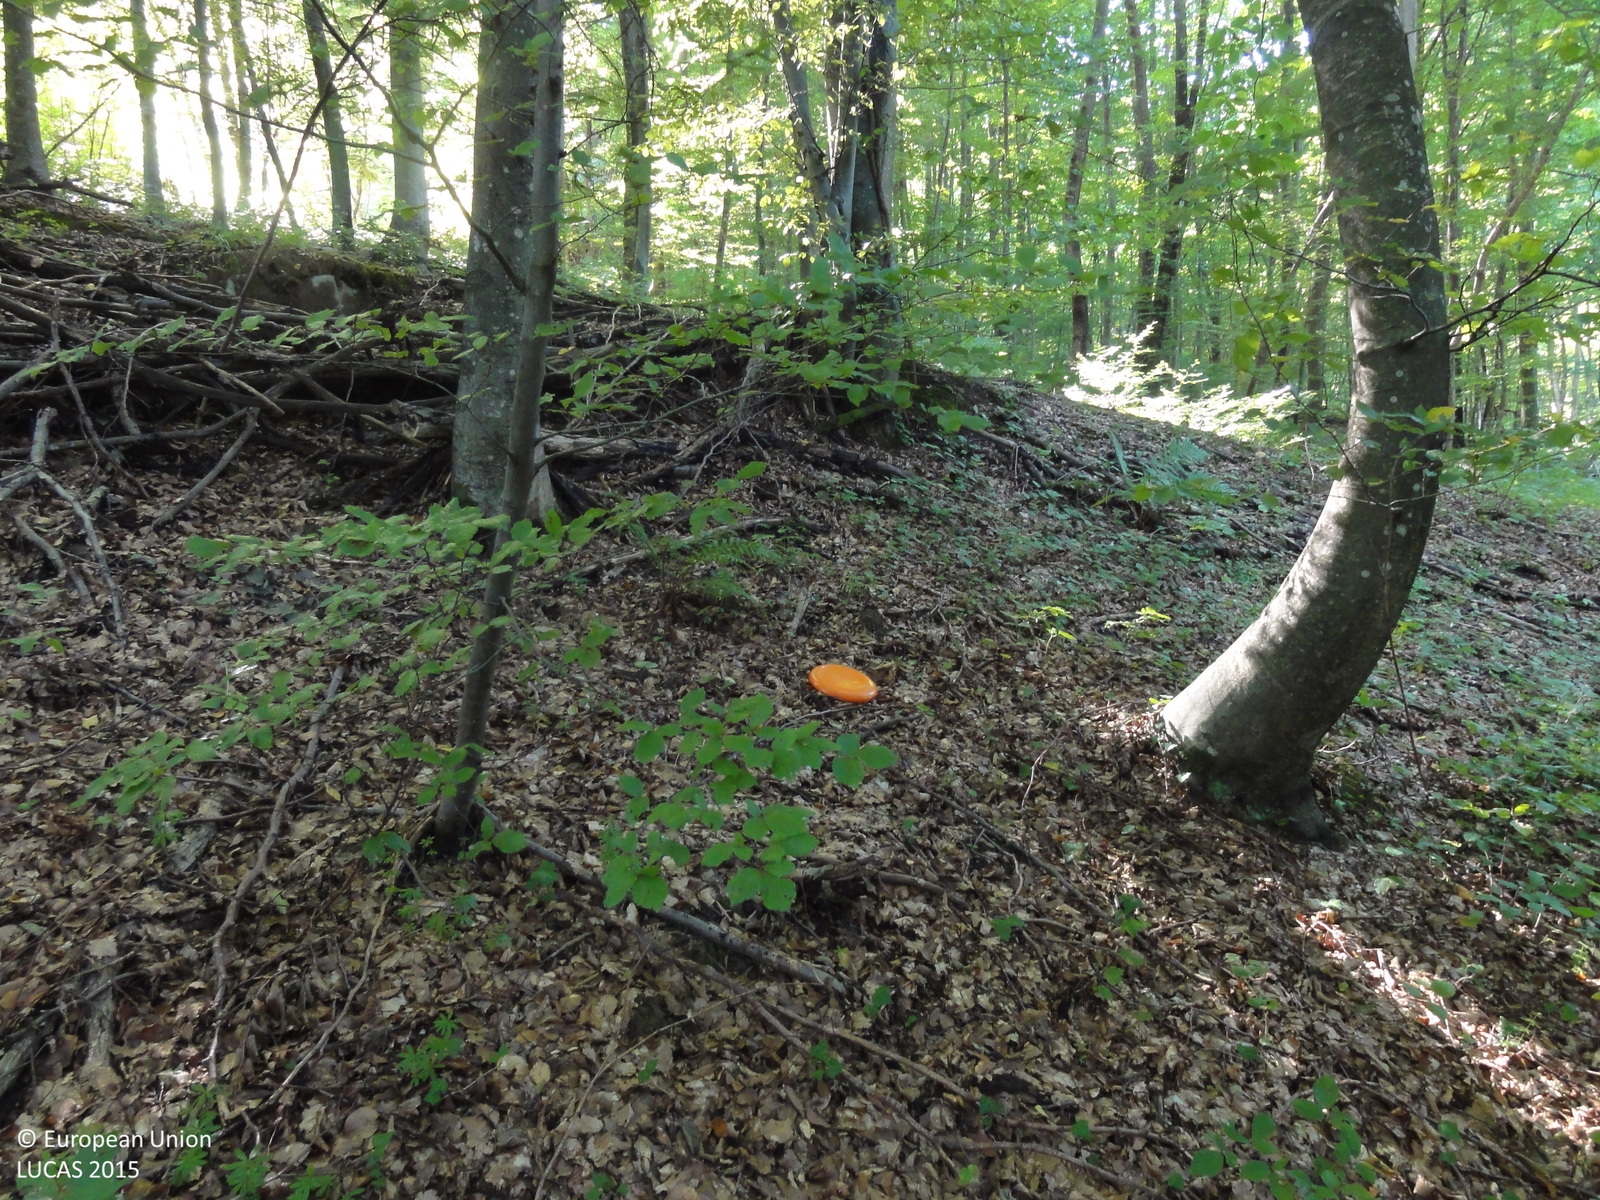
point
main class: Woodland
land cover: Broadleaved woodland
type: beech forest
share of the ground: > 75 %
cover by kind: broadleaved forest trees 100 %
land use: Forestry
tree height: > 5 m
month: September
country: SI
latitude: 45.8143
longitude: 15.4665
